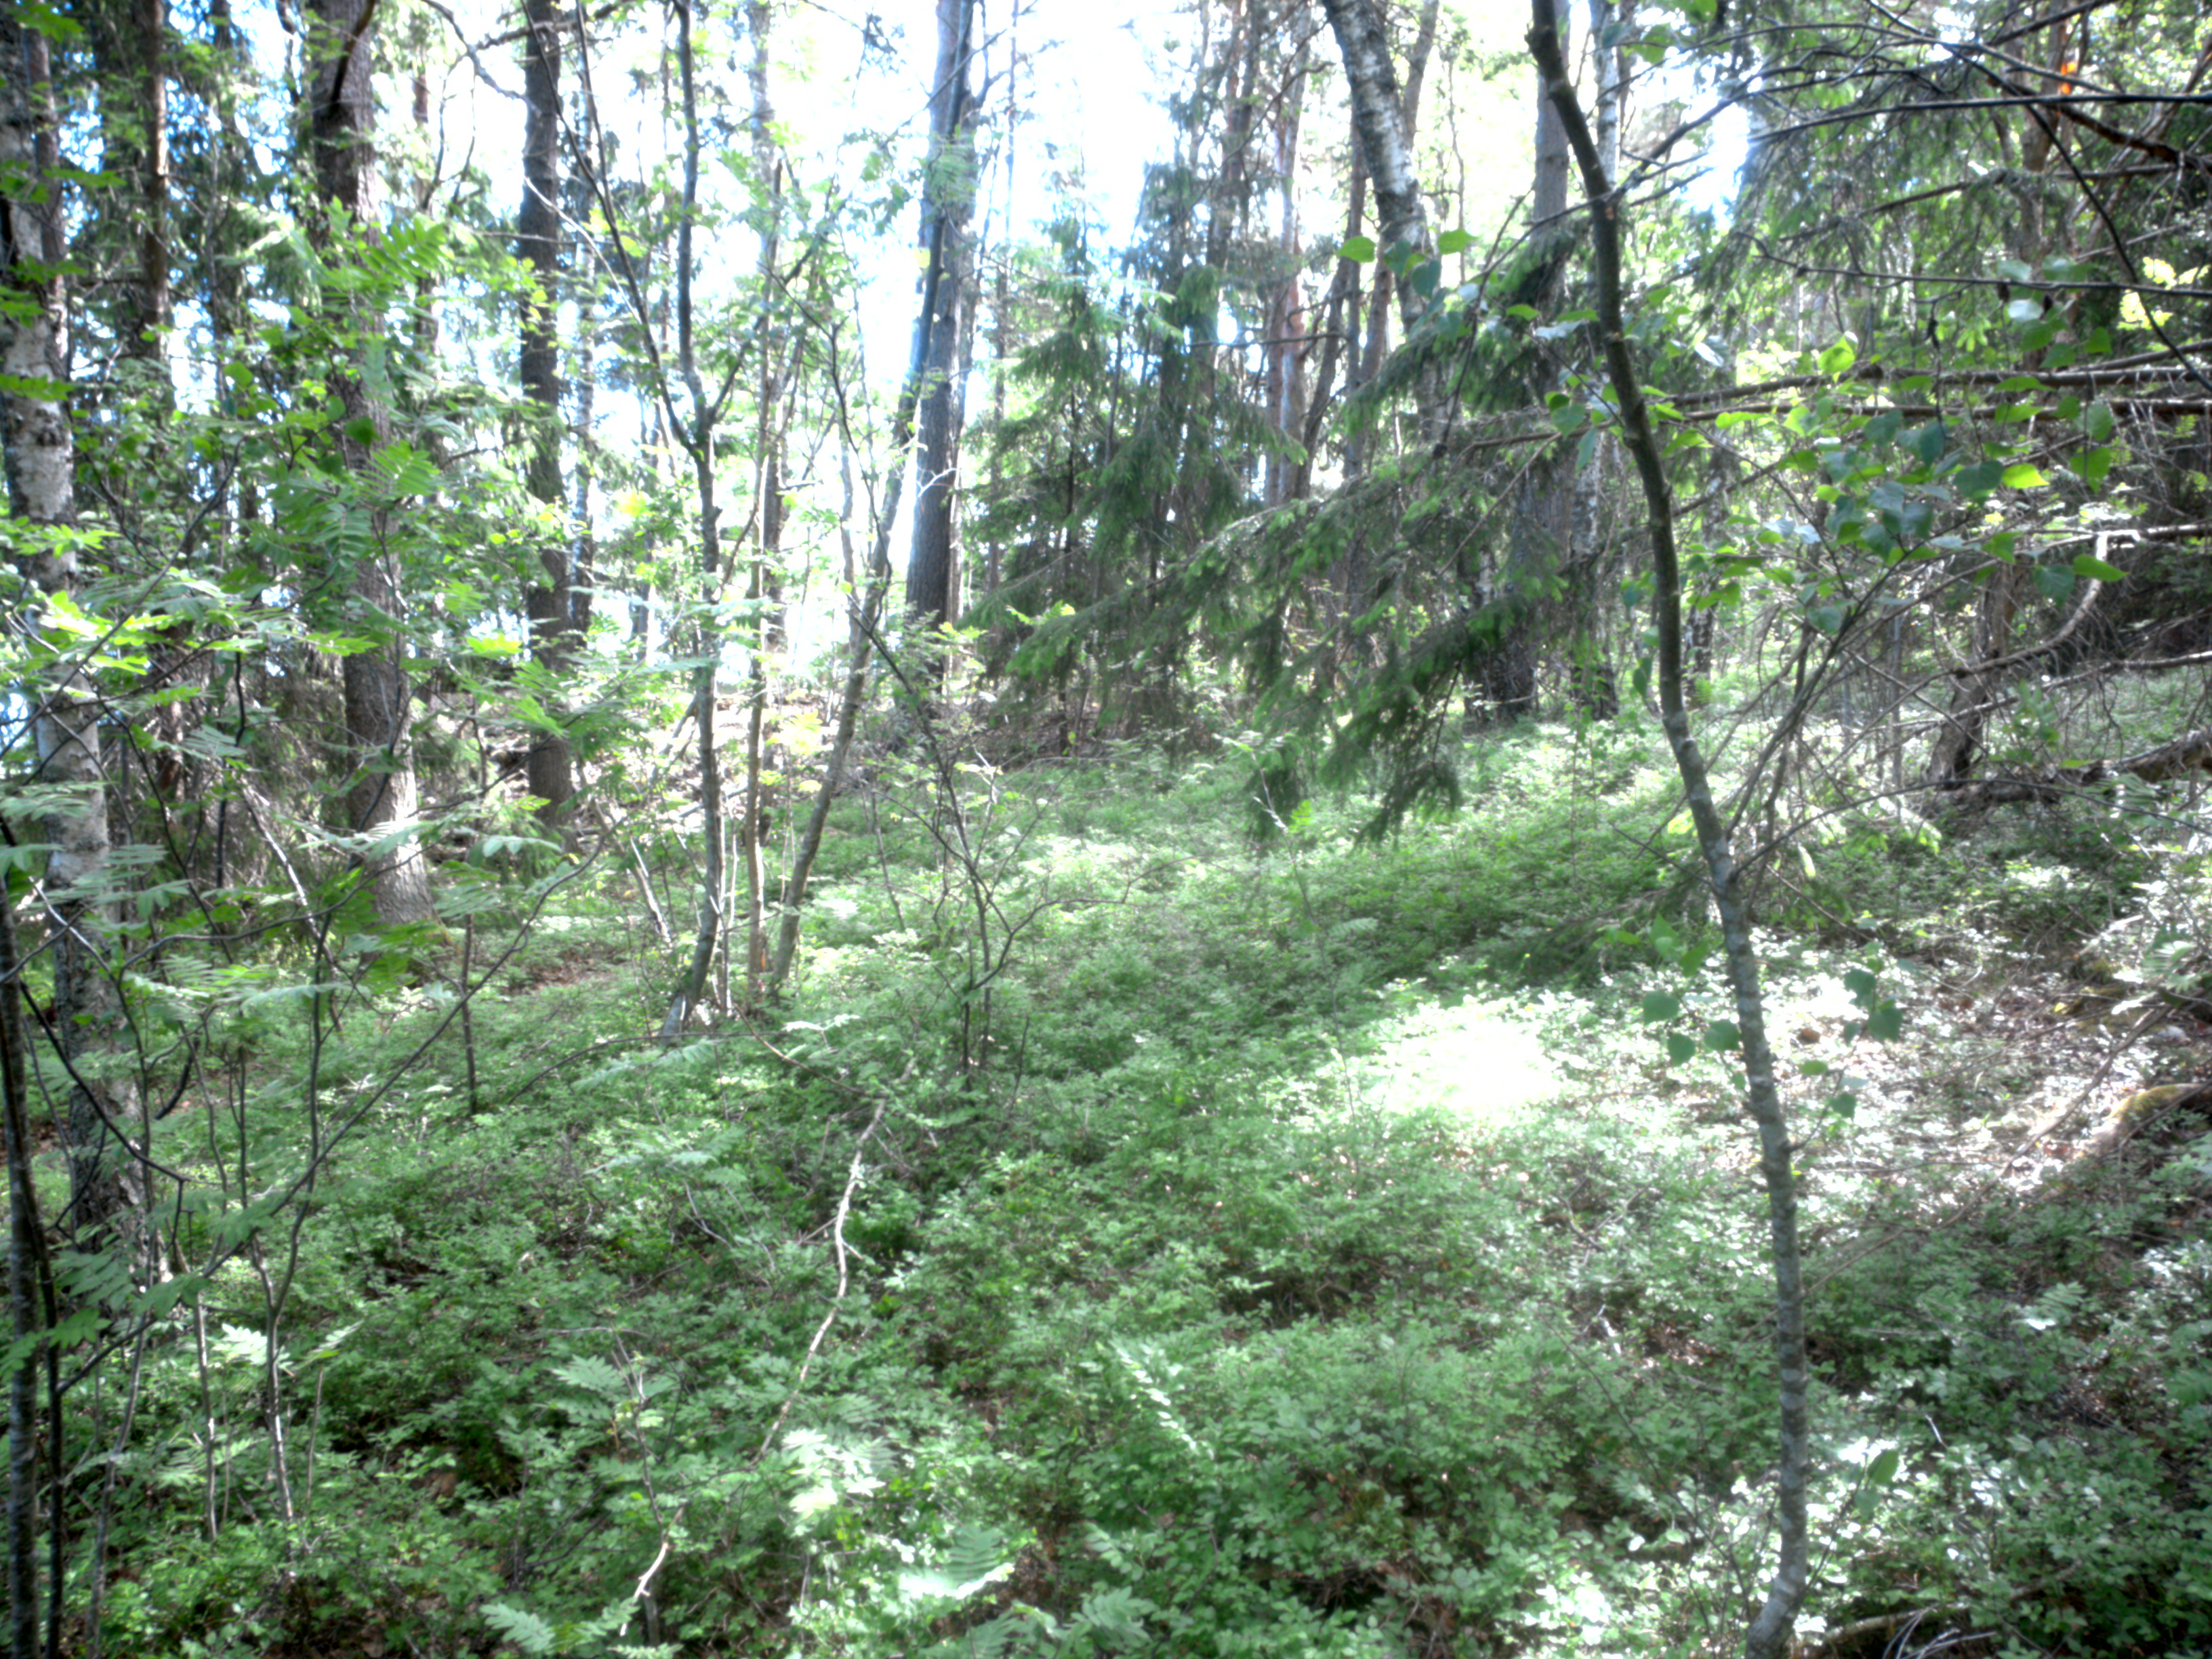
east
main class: Woodland
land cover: Broadleaved woodland
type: non-riverine alder, birch or aspen forest
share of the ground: > 75 %
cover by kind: broadleaved forest trees 80 %, coniferous forest trees 10 %, shrubs 5 %, herbaceous plants 5 %
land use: Forestry
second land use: Amenities, museums, leisure
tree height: > 5 m
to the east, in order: Broadleaved woodland; Pine dominated mixed woodland; Spruce dominated mixed woodland; Spruce dominated coniferous woodland
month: June
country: SE
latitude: 59.3202
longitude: 17.6754
